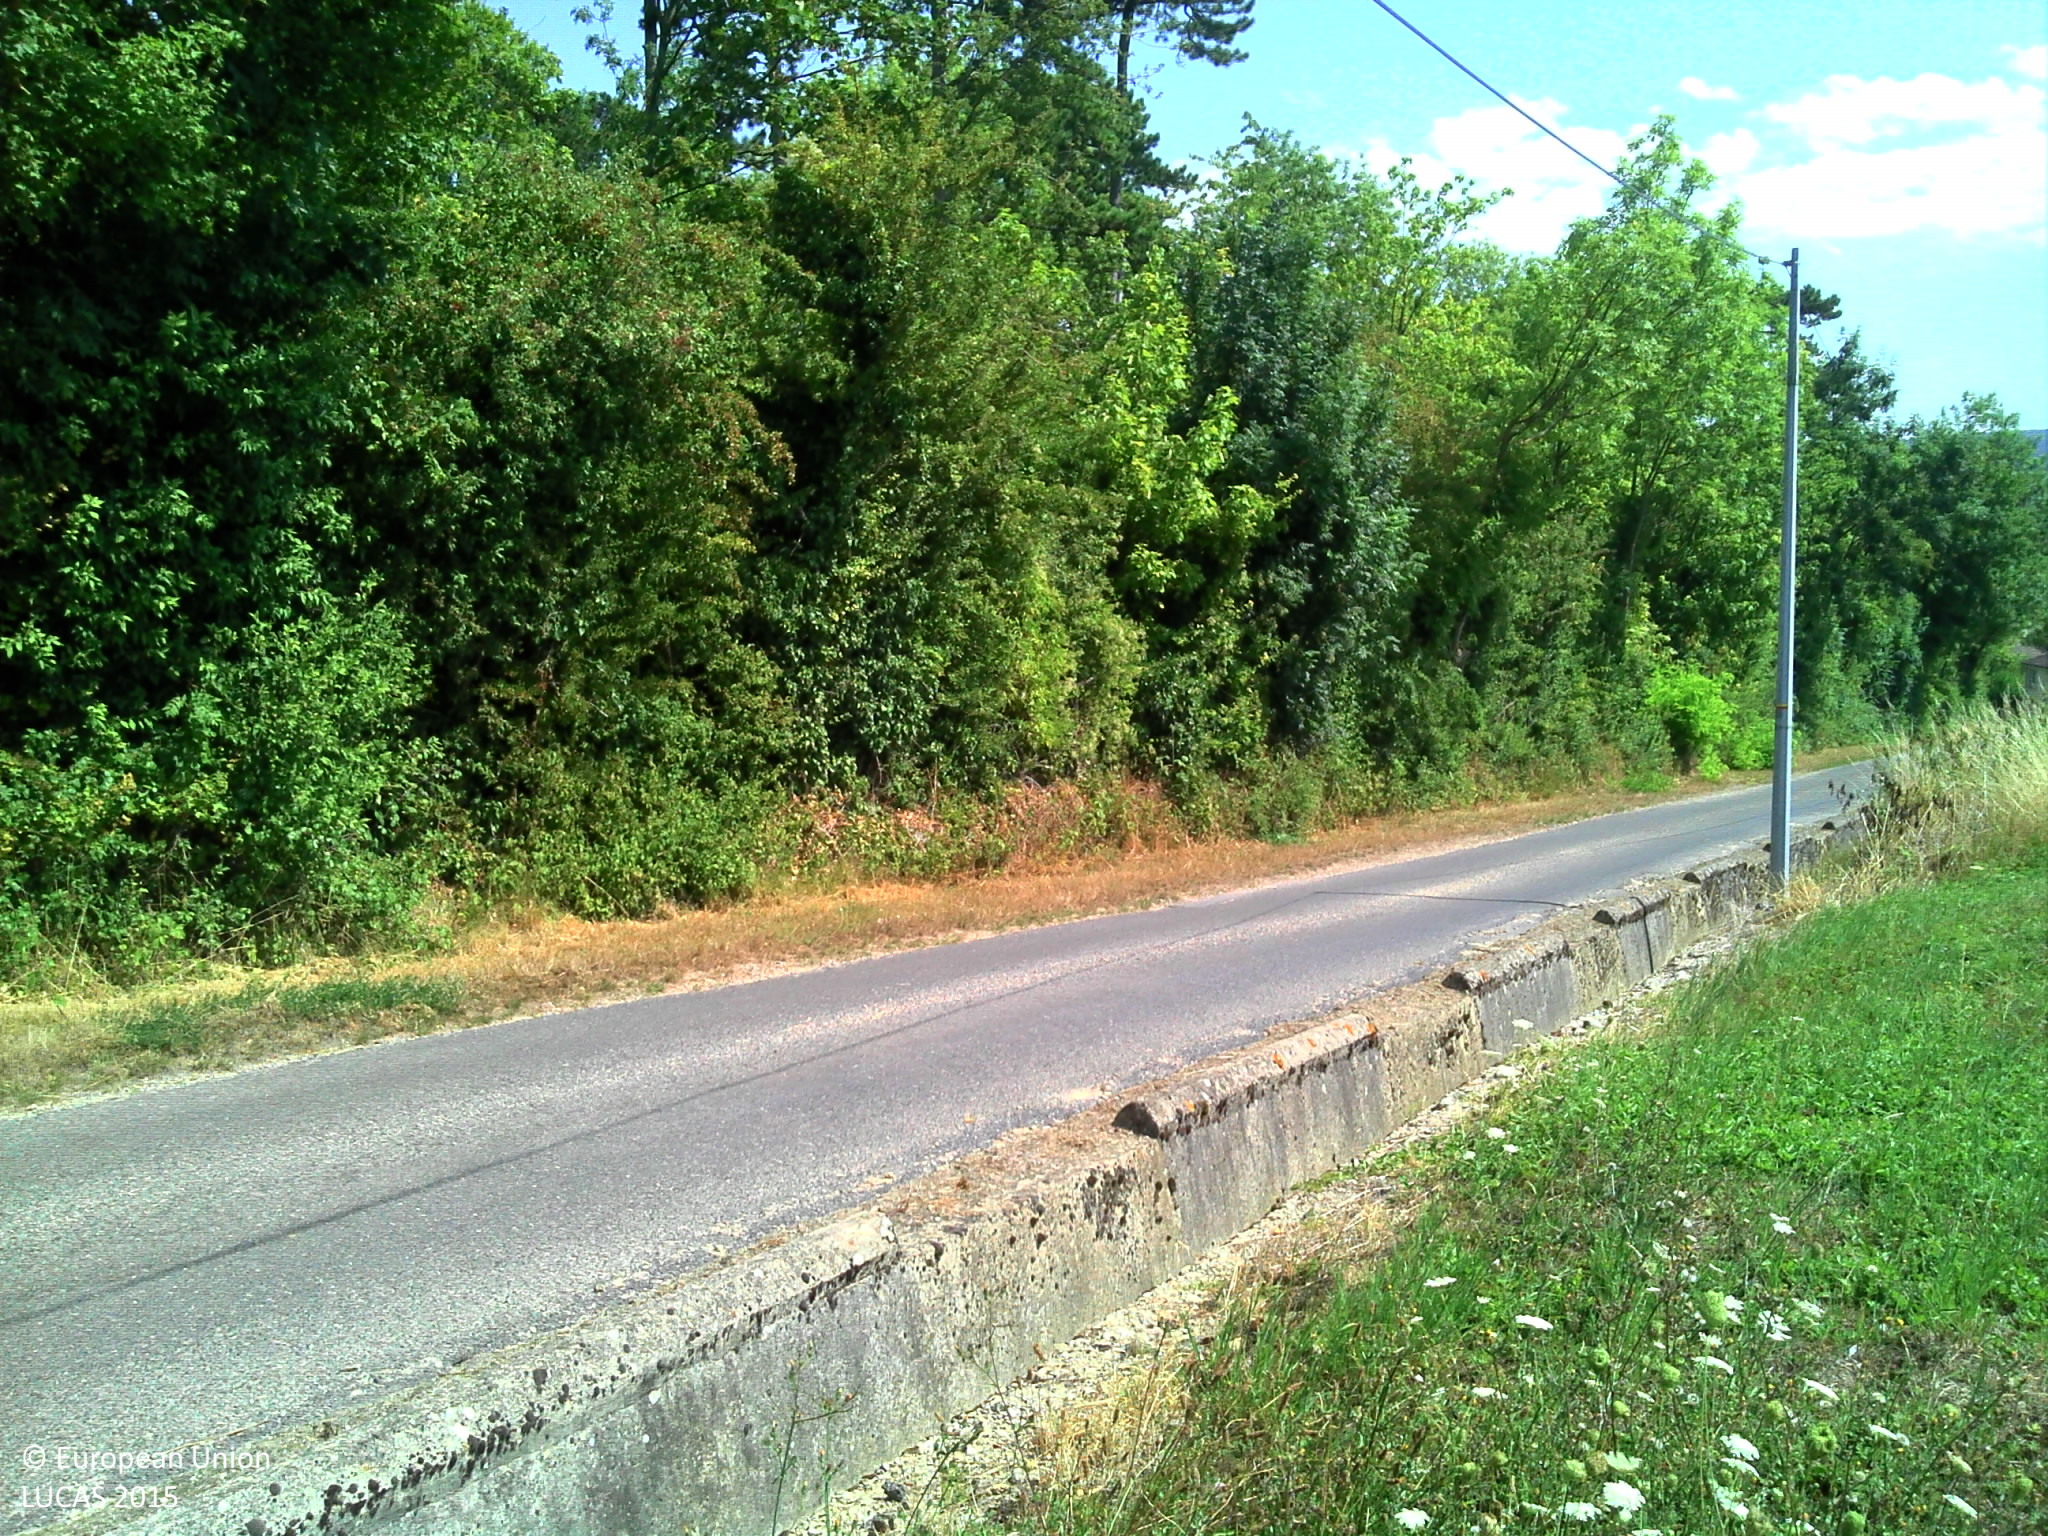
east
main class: Grassland
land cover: Grassland without tree/shrub cover
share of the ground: > 75 %
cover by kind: herbaceous plants 85 %, consolidated bare surface 5 %, unconsolidated bare surface 5 %
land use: Semi-natural and natural areas not in use
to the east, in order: Grassland without tree/shrub cover; Electric lines; Ditches and canals; Paved roads, cycling and walking lanes; Grass margins; Artificial constructions; Broadleaved woodland; Grassland without tree/shrub cover; Broadleaved woodland; Grassland without tree/shrub cover
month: August
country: FR
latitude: 49.1099
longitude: 3.7336
